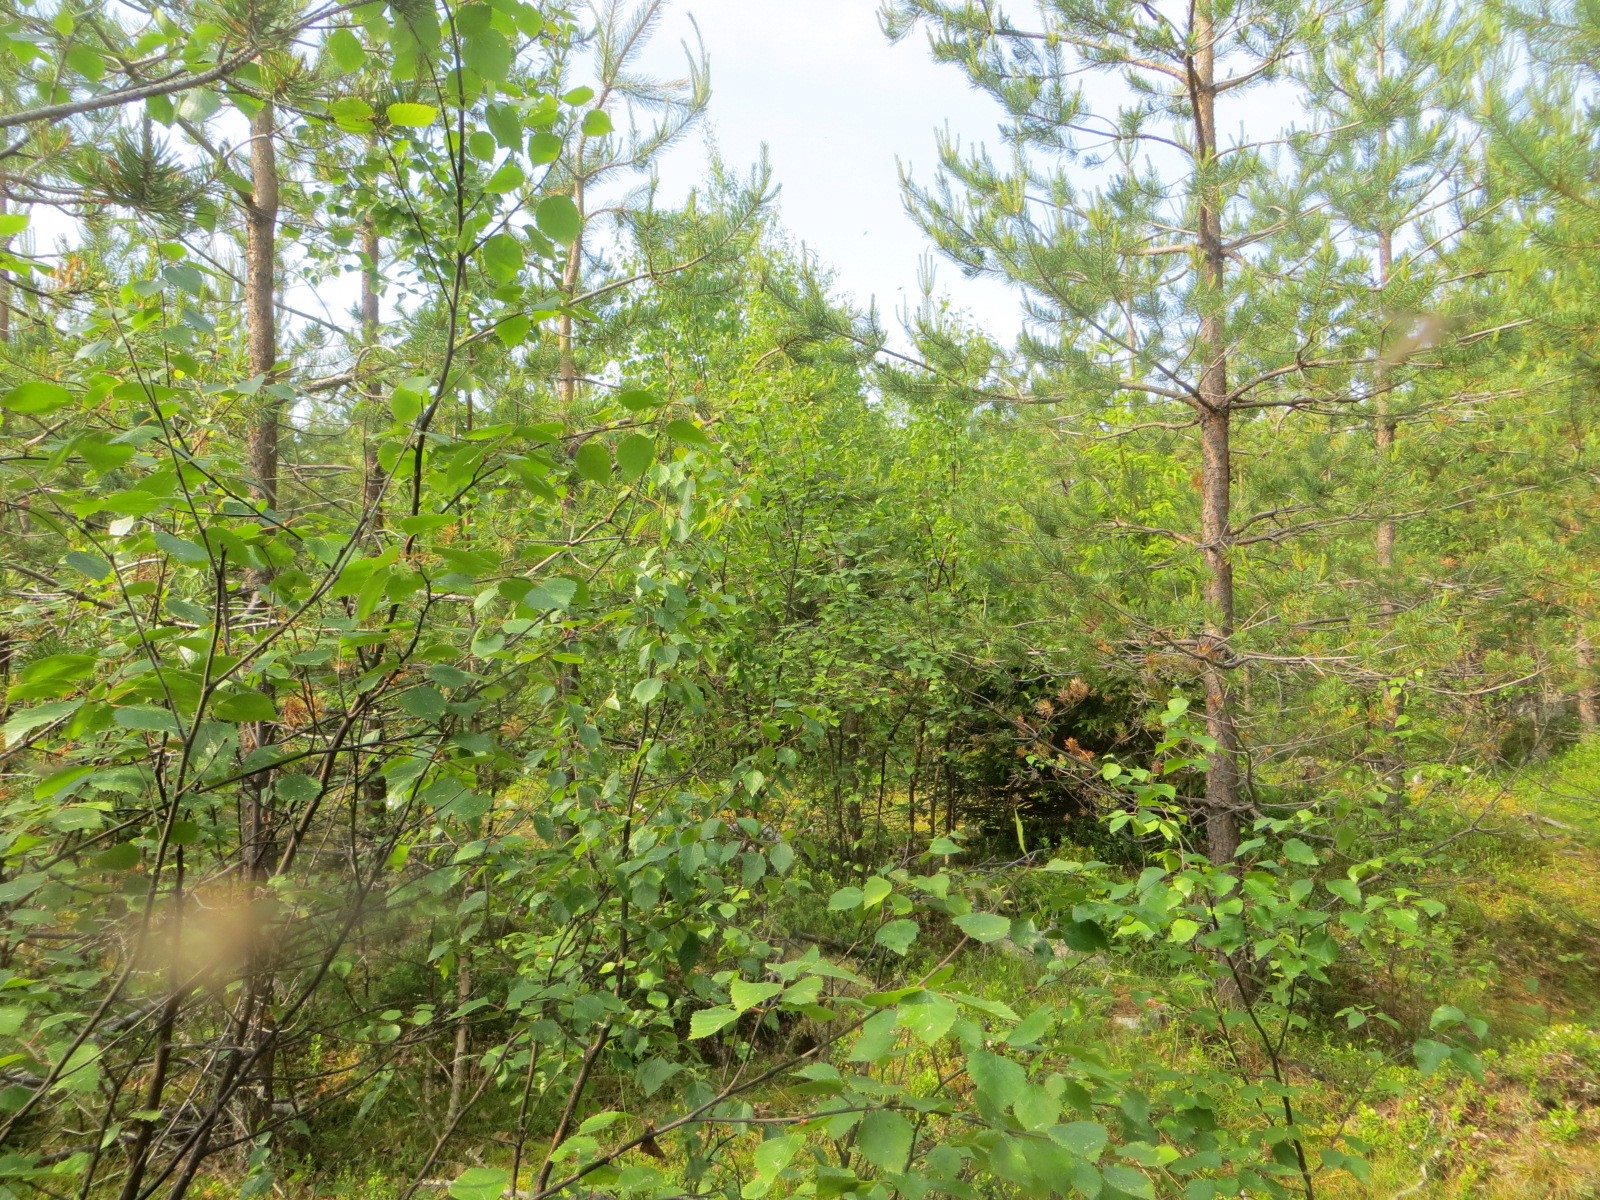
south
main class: Woodland
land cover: Pine dominated mixed woodland
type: boreal forest
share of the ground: > 75 %
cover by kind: coniferous forest trees 50 %, broadleaved forest trees 35 %, shrubs 5 %, herbaceous plants 5 %, lichens and mosses 5 %
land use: Forestry
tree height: > 5 m
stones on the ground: 25 - 50 %
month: July
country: FI
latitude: 65.5065
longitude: 25.7994
